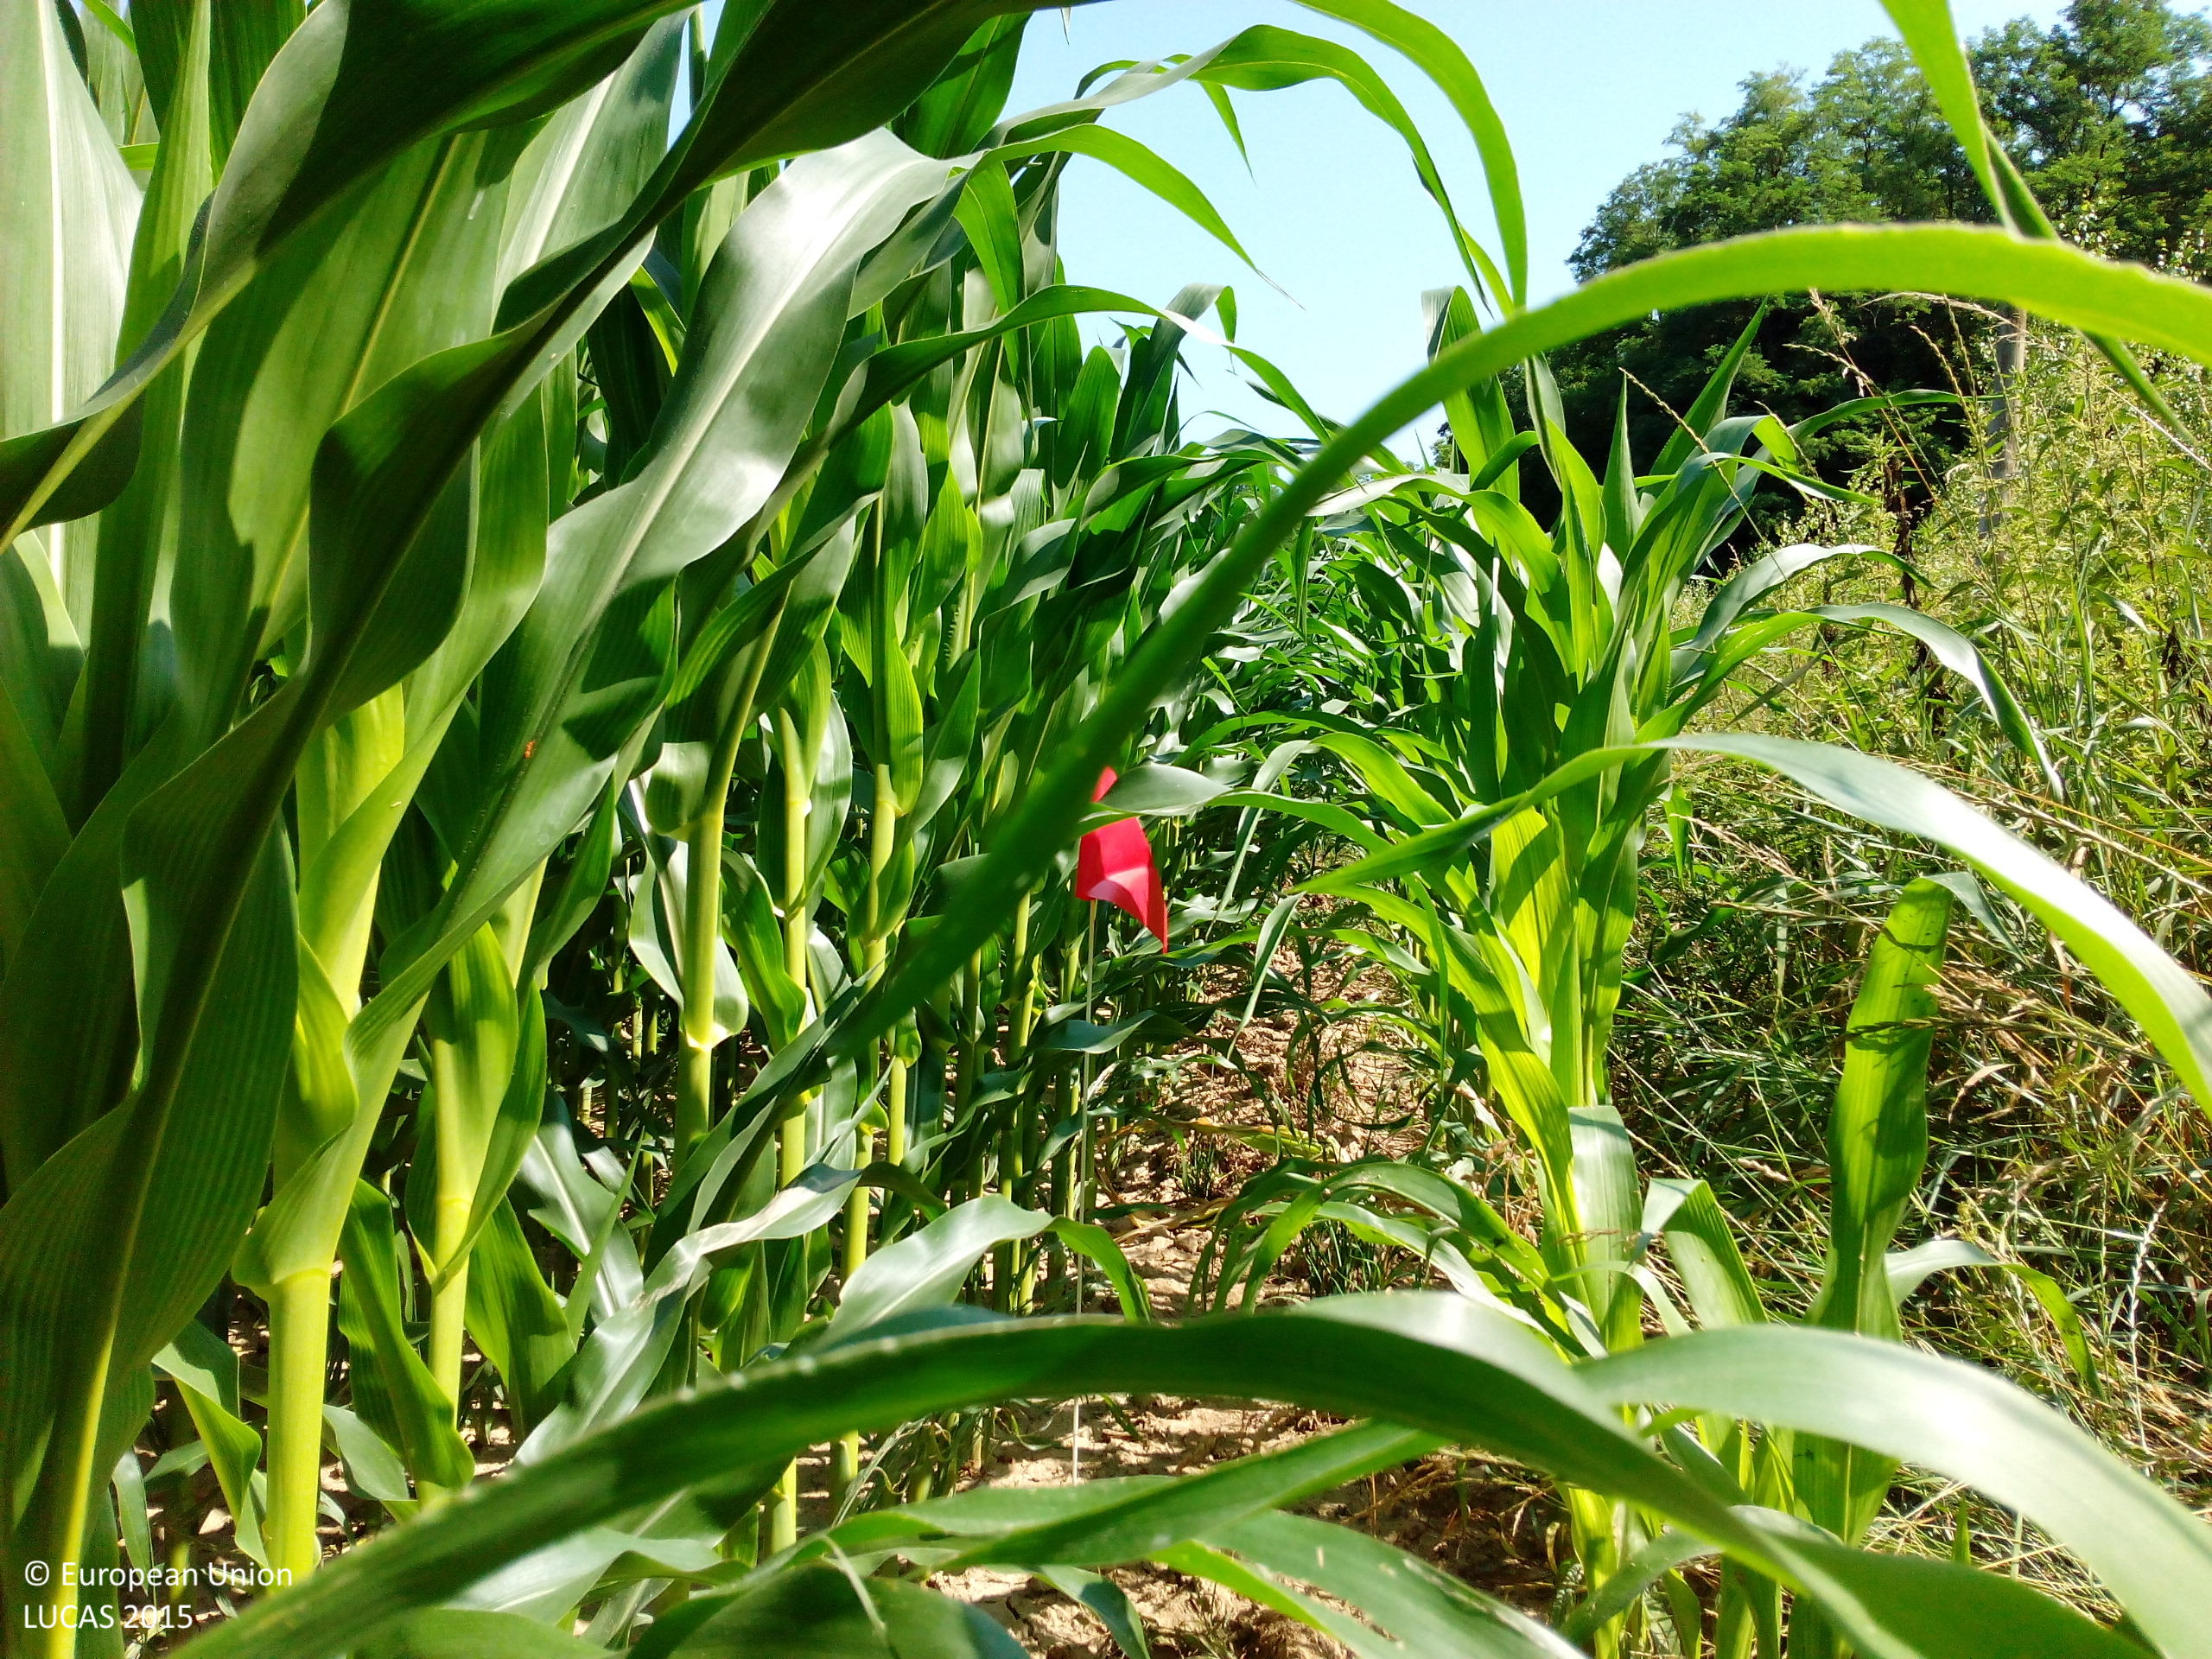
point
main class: Cropland
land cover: Maize
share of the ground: > 75 %
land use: Agriculture (excluding fallow land and kitchen gardens)
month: July
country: DE
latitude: 47.8381
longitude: 7.6364
